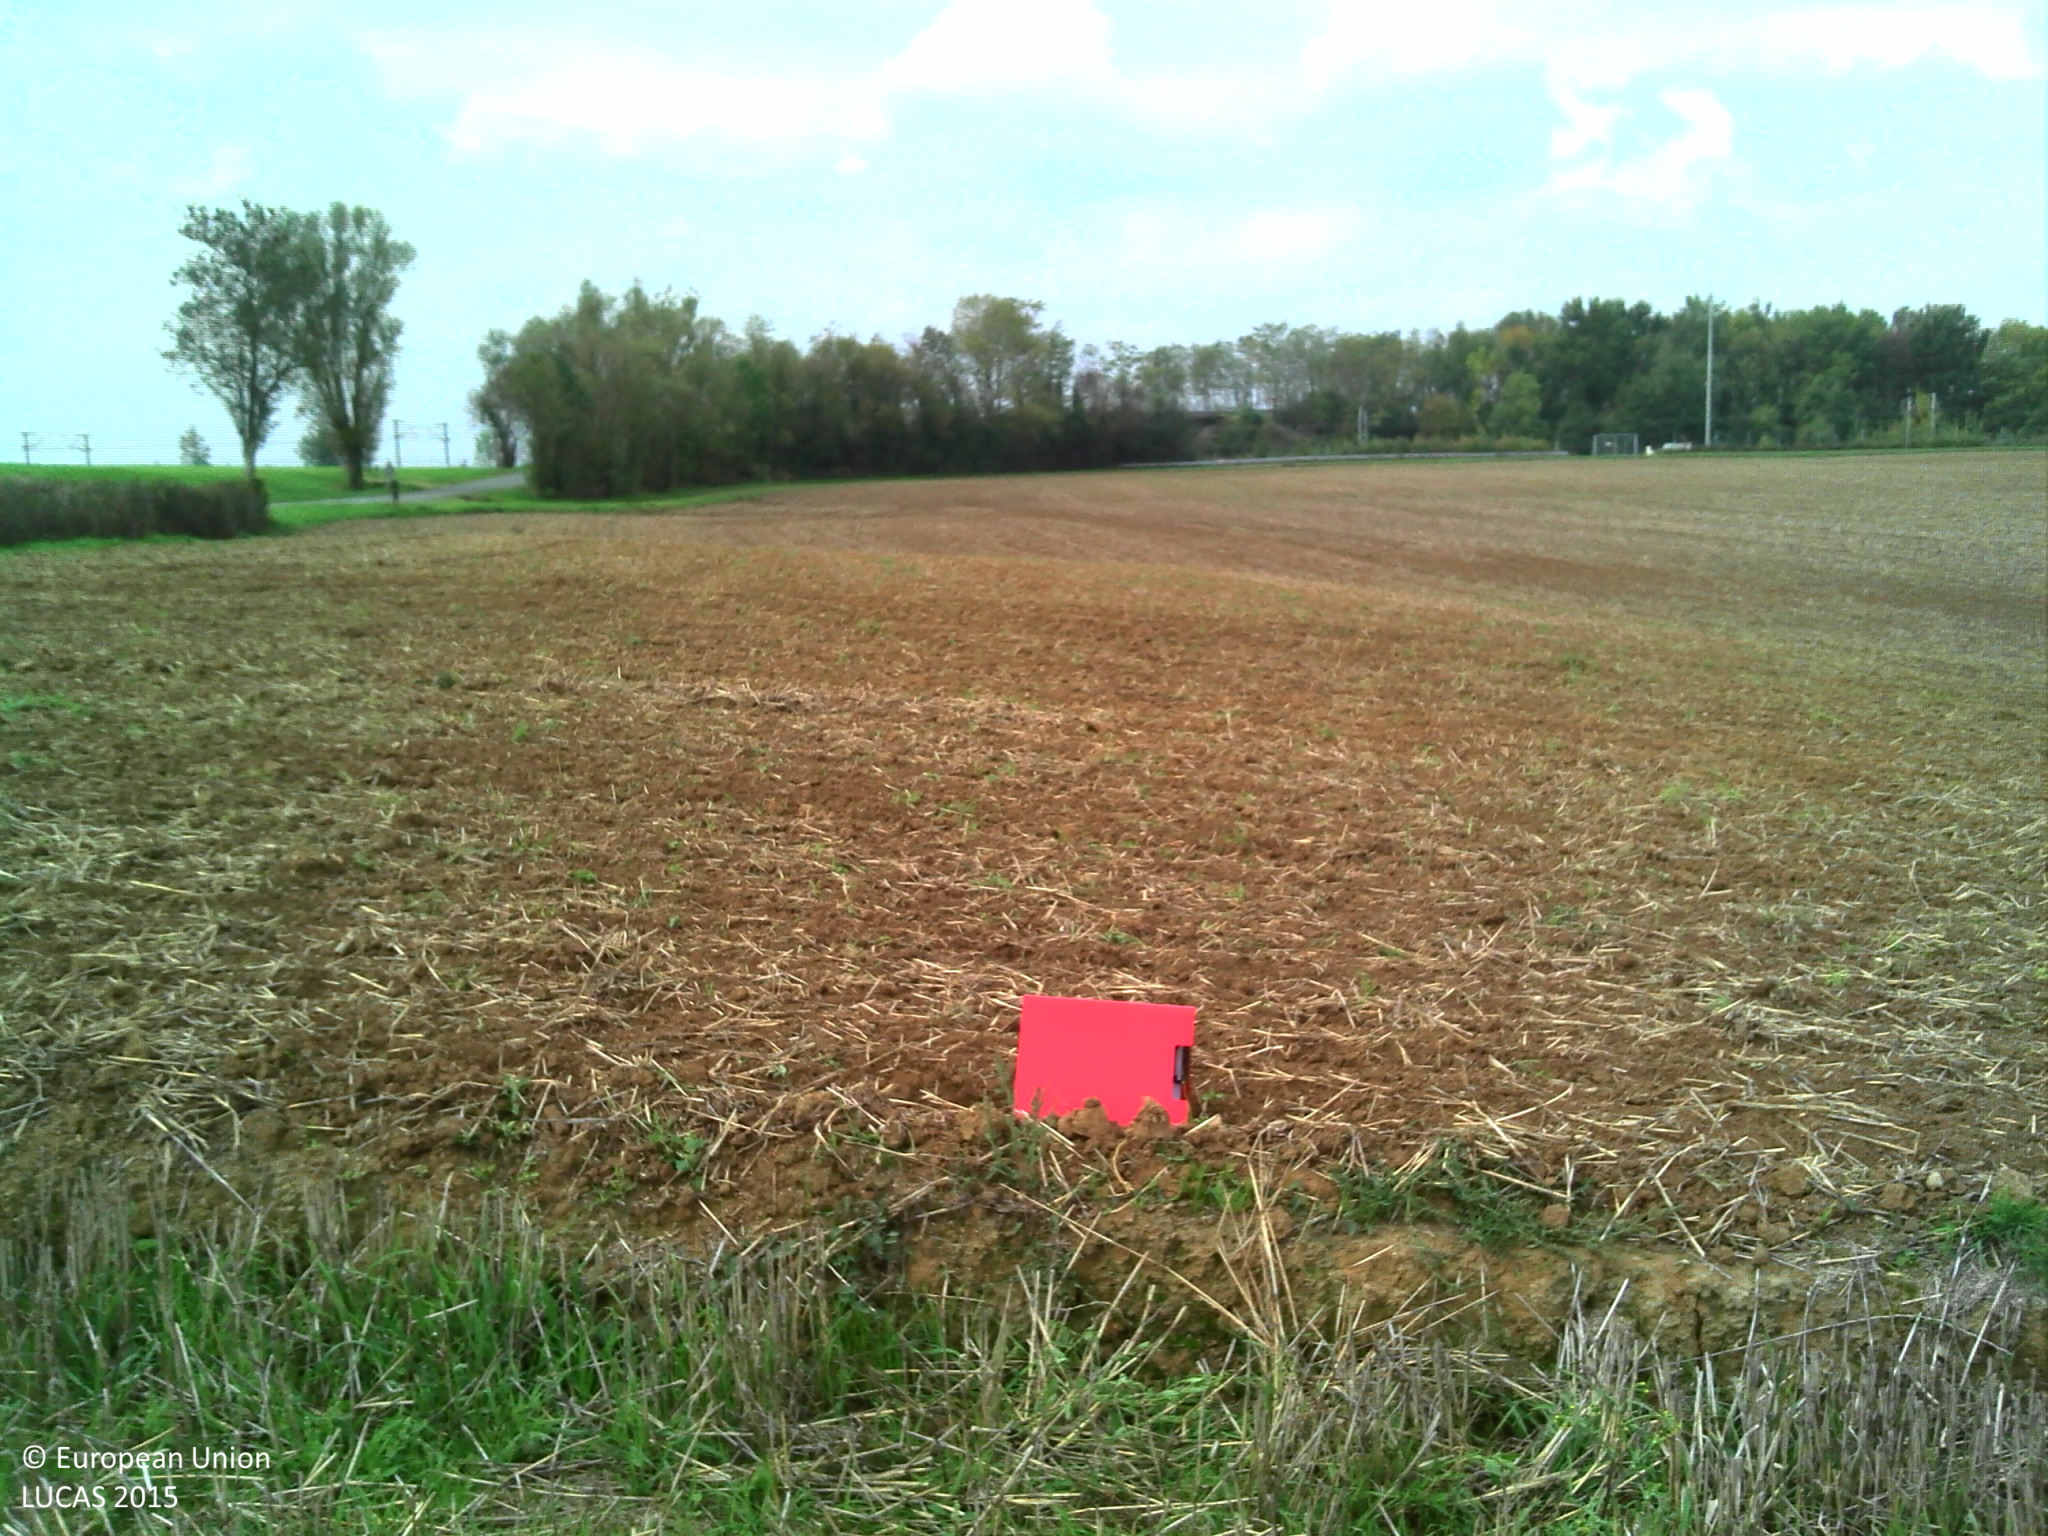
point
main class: Cropland
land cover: Common wheat
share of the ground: < 10 %
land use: Agriculture (excluding fallow land and kitchen gardens)
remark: Harvested field
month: October
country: FR
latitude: 46.1915
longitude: 4.8586
